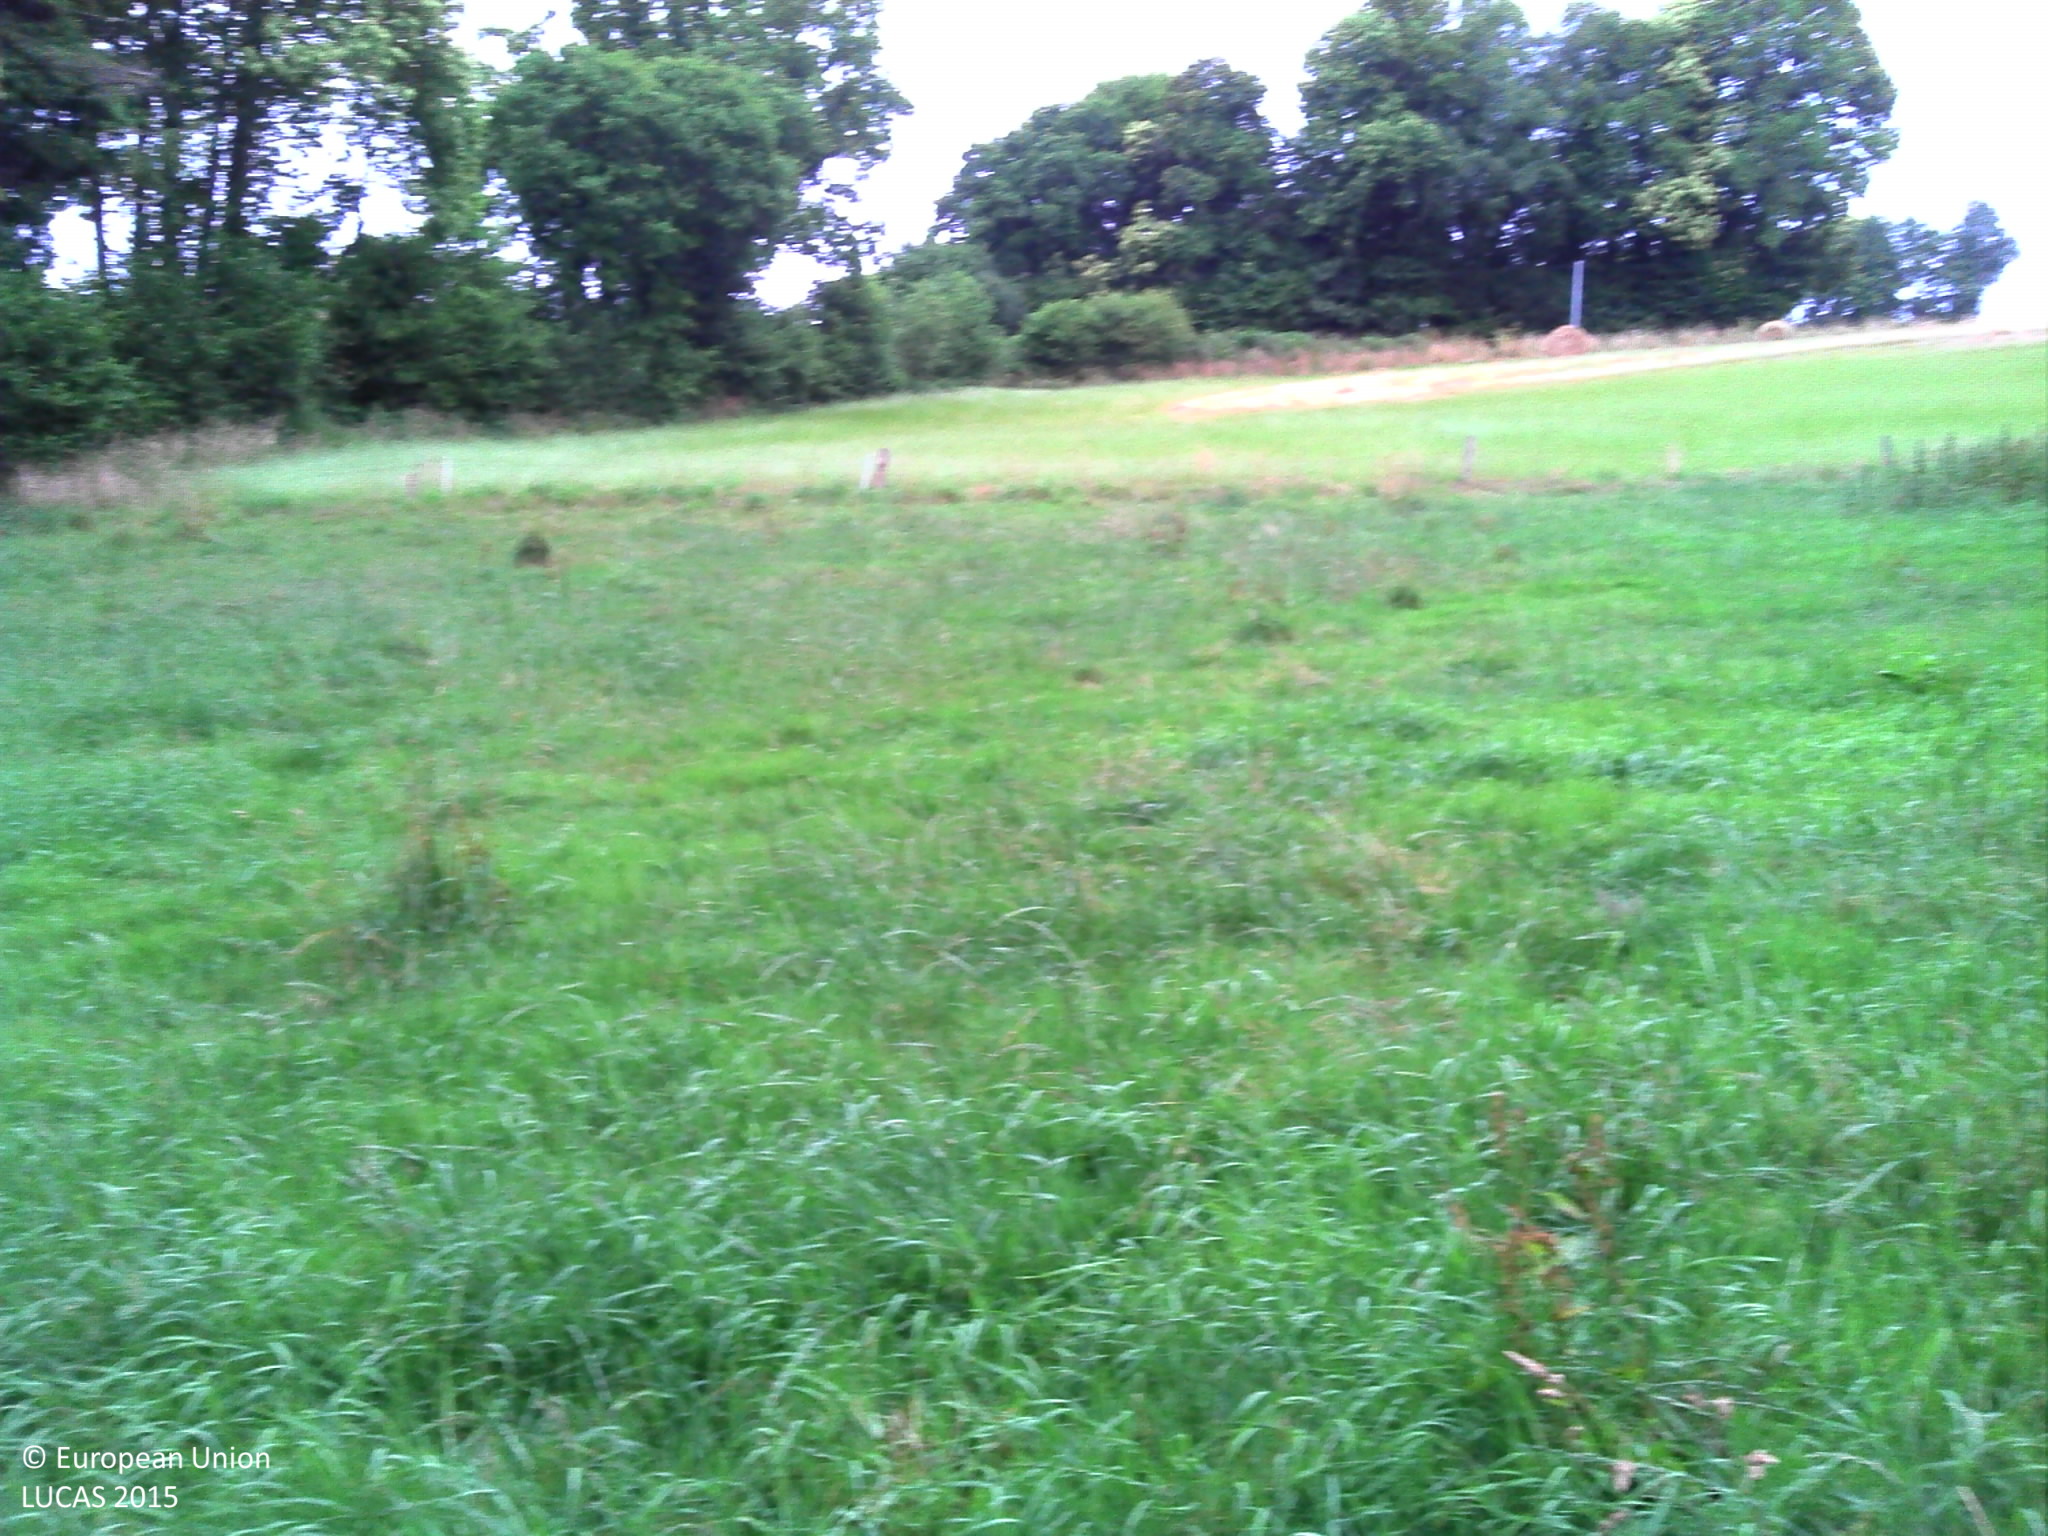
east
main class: Grassland
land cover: Grassland without tree/shrub cover
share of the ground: > 75 %
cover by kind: herbaceous plants 80 %, consolidated bare surface 20 %
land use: Agriculture (excluding fallow land and kitchen gardens)
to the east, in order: Grassland without tree/shrub cover; Fences; Mixed cereals for fodder; Fences; Ditches and canals; Broadleaved woodland; Fences; Grassland without tree/shrub cover; Fences; Electric lines; Grass margins; Paved roads, cycling and walking lanes; Grass margins; Temporary grasslands; Electric lines; Temporary grasslands
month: July
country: FR
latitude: 48.0667
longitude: -3.6198
